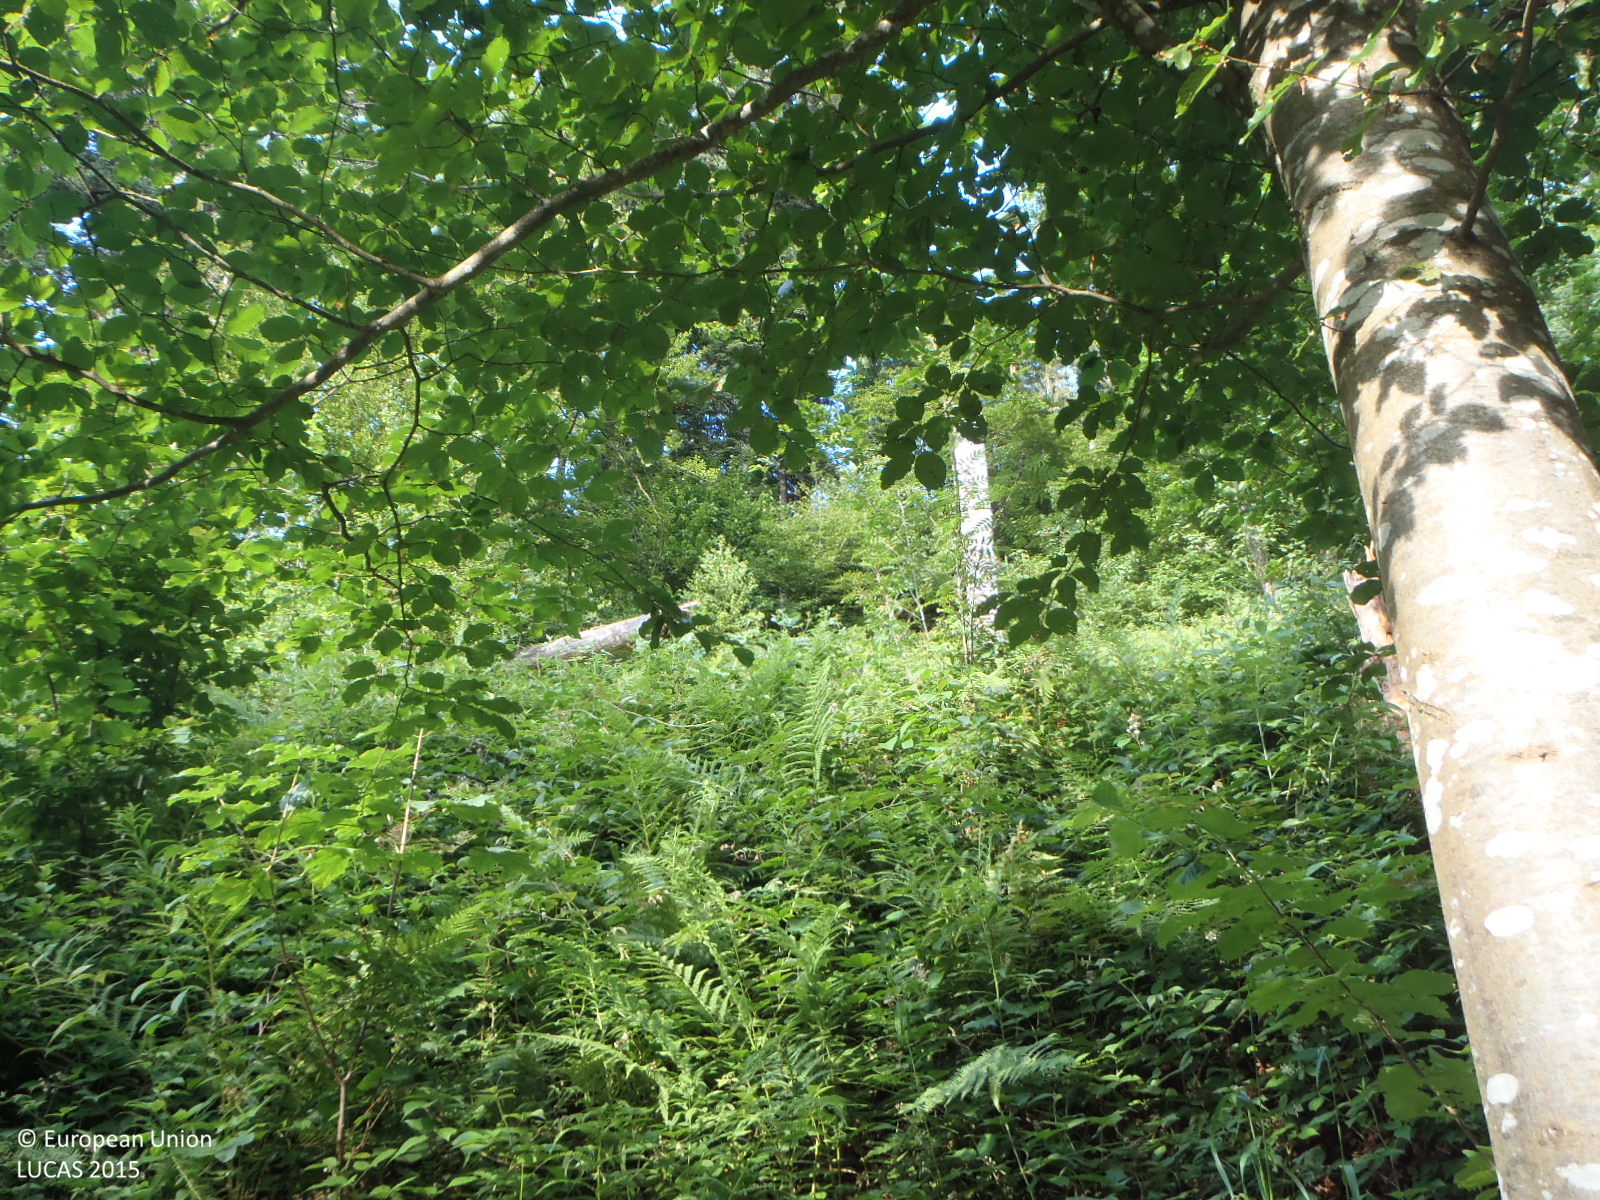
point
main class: Woodland
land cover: Other mixed woodland
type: alpine coniferous forest
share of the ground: > 75 %
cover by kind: coniferous forest trees 35 %, broadleaved forest trees 30 %, shrubs 20 %, herbaceous plants 15 %
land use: Forestry
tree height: > 5 m
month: July
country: AT
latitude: 47.5126
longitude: 12.4283
